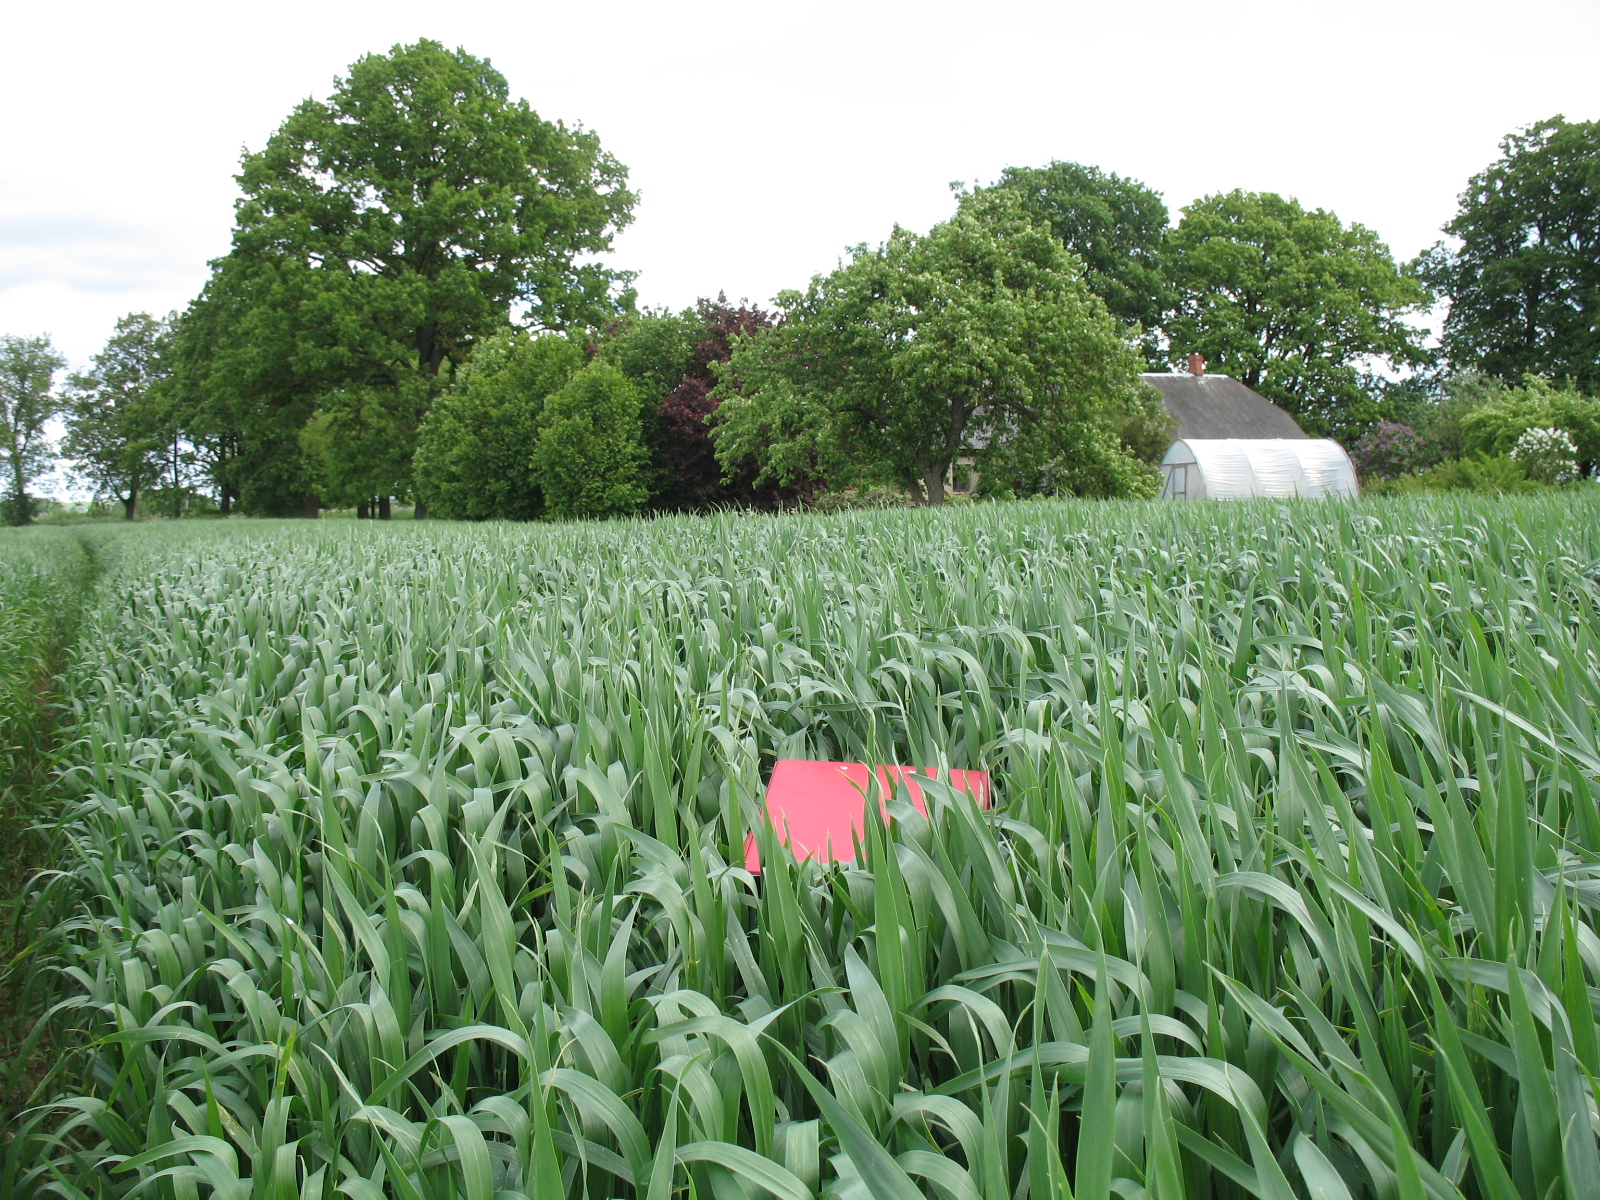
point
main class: Cropland
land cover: Common wheat
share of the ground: > 75 %
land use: Agriculture (excluding fallow land and kitchen gardens)
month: June
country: LV
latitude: 56.6956
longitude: 23.4804
